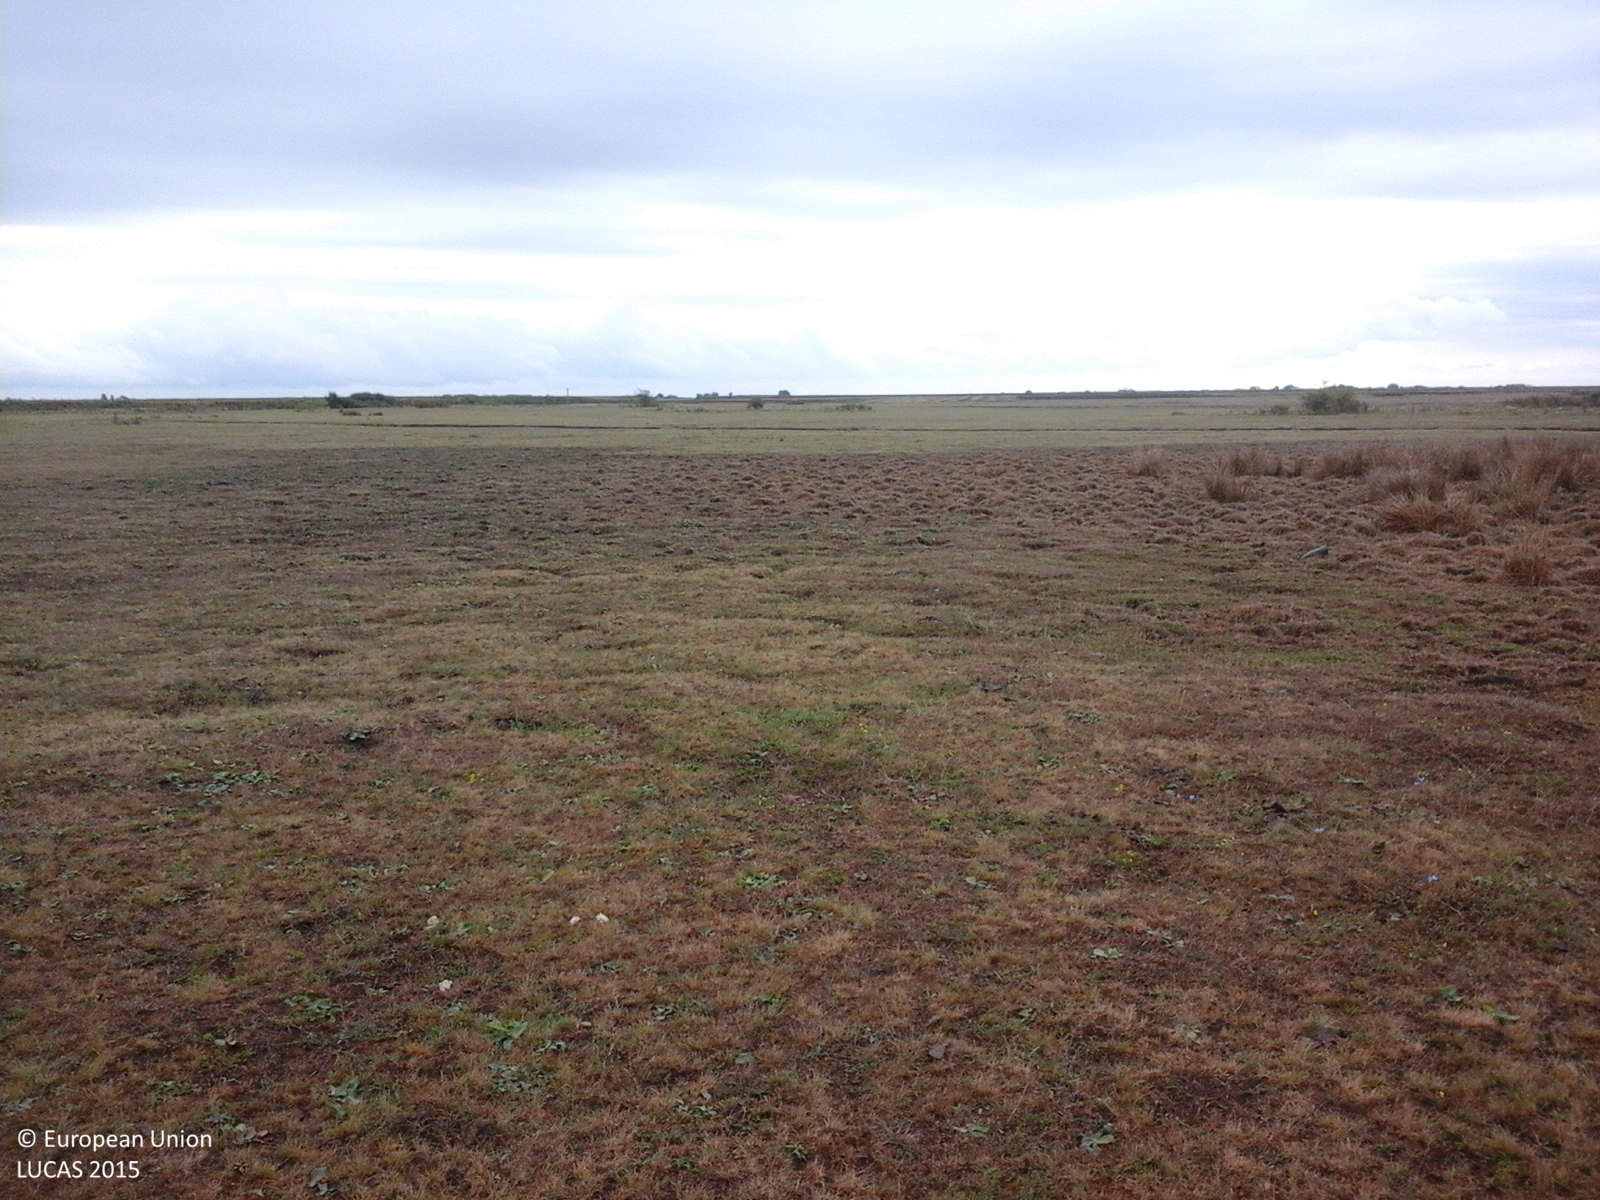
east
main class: Grassland
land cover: Grassland without tree/shrub cover
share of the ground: > 75 %
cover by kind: herbaceous plants 100 %
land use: Agriculture (excluding fallow land and kitchen gardens)
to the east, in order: Grassland without tree/shrub cover; Ditches and canals; Grassland without tree/shrub cover; Single bushes/trees; Grassland without tree/shrub cover
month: August
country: RO
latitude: 45.5455
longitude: 21.0033
